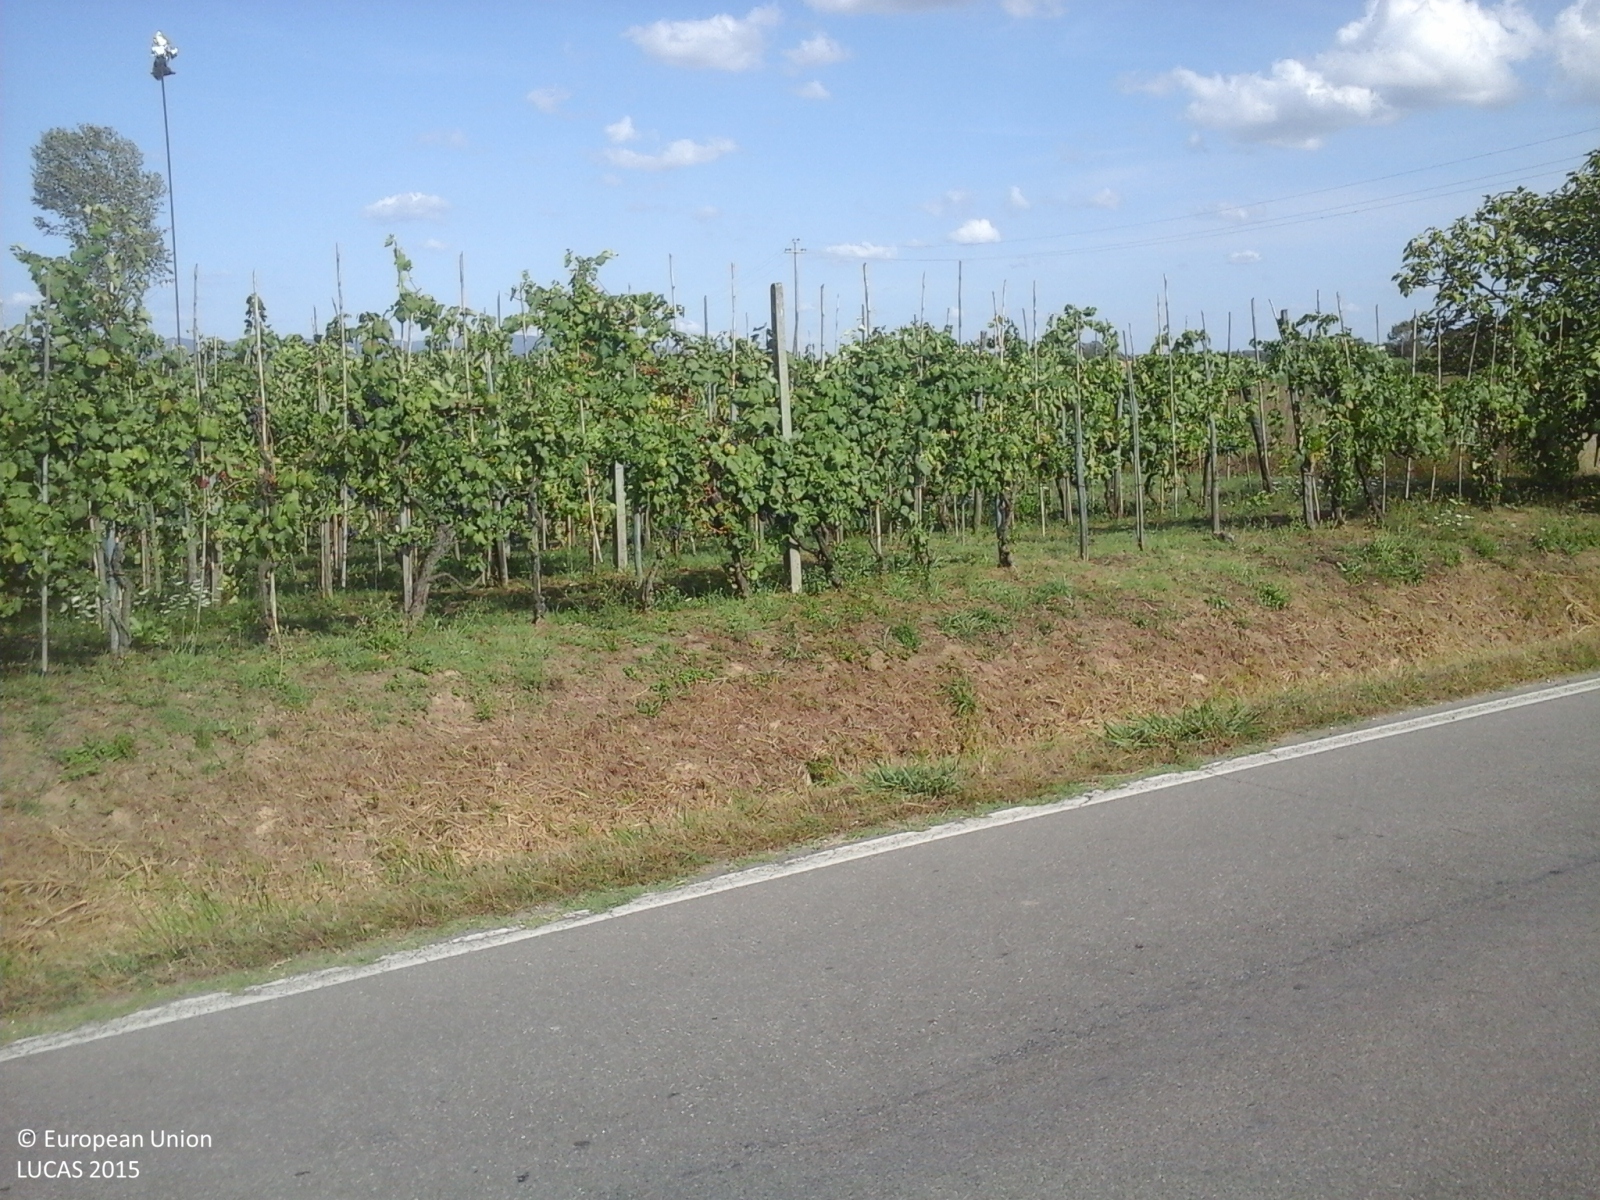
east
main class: Cropland
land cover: Maize
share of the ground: > 75 %
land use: Agriculture (excluding fallow land and kitchen gardens)
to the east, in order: Maize; Grass margins; Paved roads, cycling and walking lanes; Grass margins; Ditches and canals; Vineyards; Spontaneously vegetated surfaces; Maize; Shrubland without tree cover; Spontaneously vegetated surfaces
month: August
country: IT
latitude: 43.8248
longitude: 10.7317
